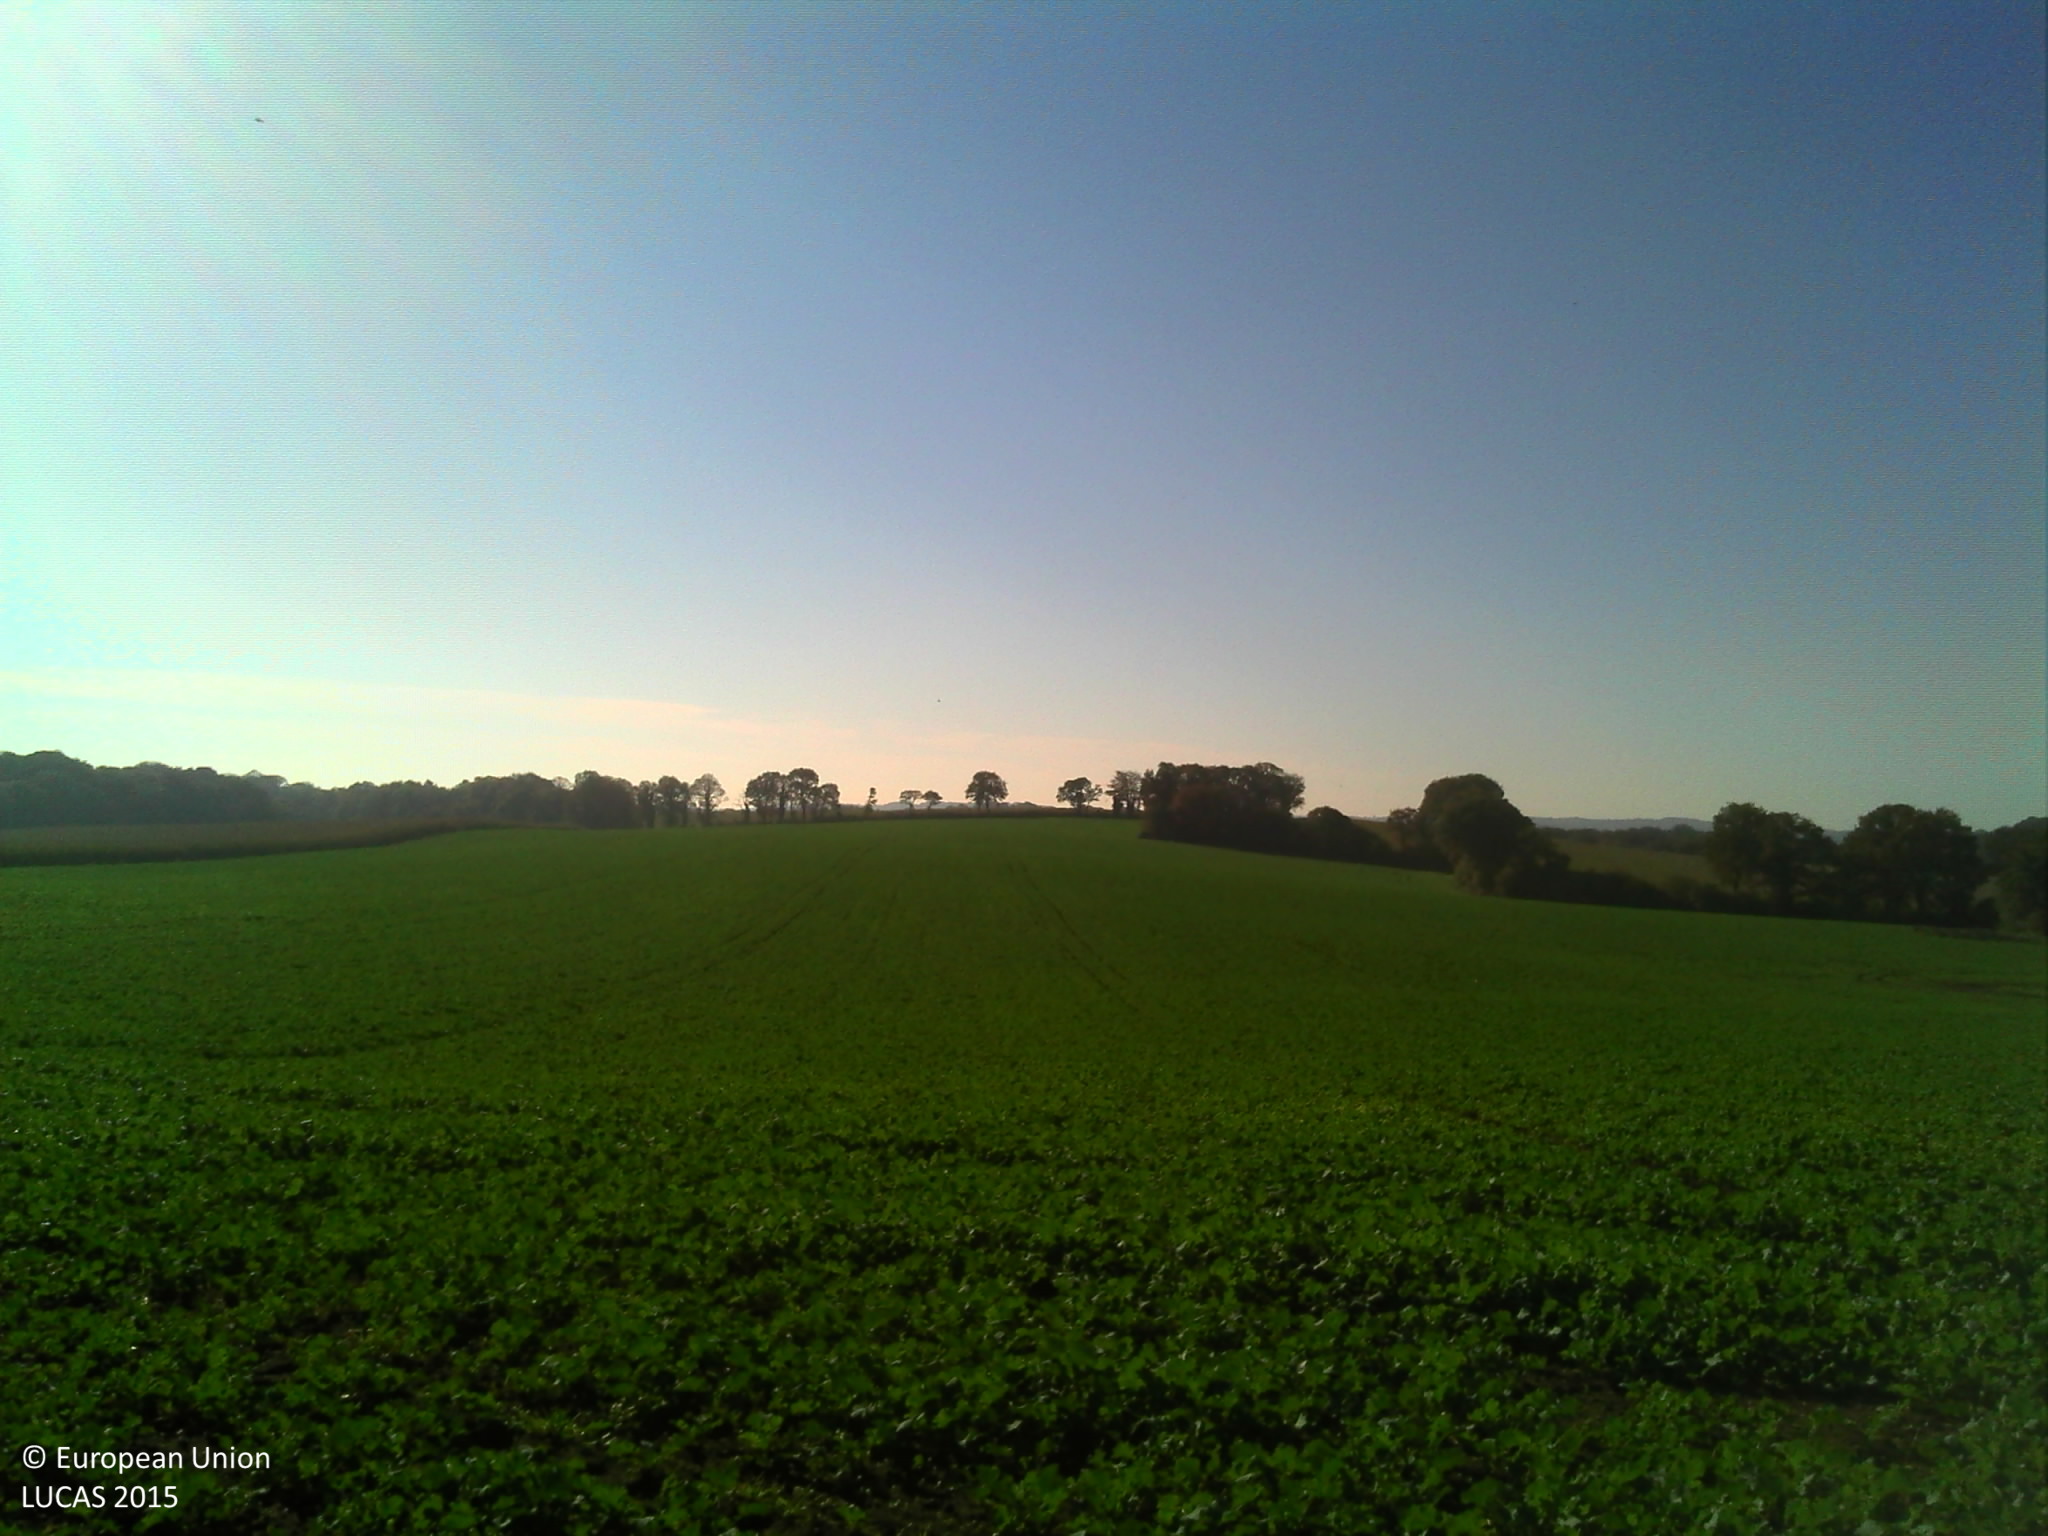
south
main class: Cropland
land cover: Rape and turnip rape
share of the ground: > 75 %
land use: Agriculture (excluding fallow land and kitchen gardens)
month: November
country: FR
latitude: 48.1365
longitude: -3.2008
